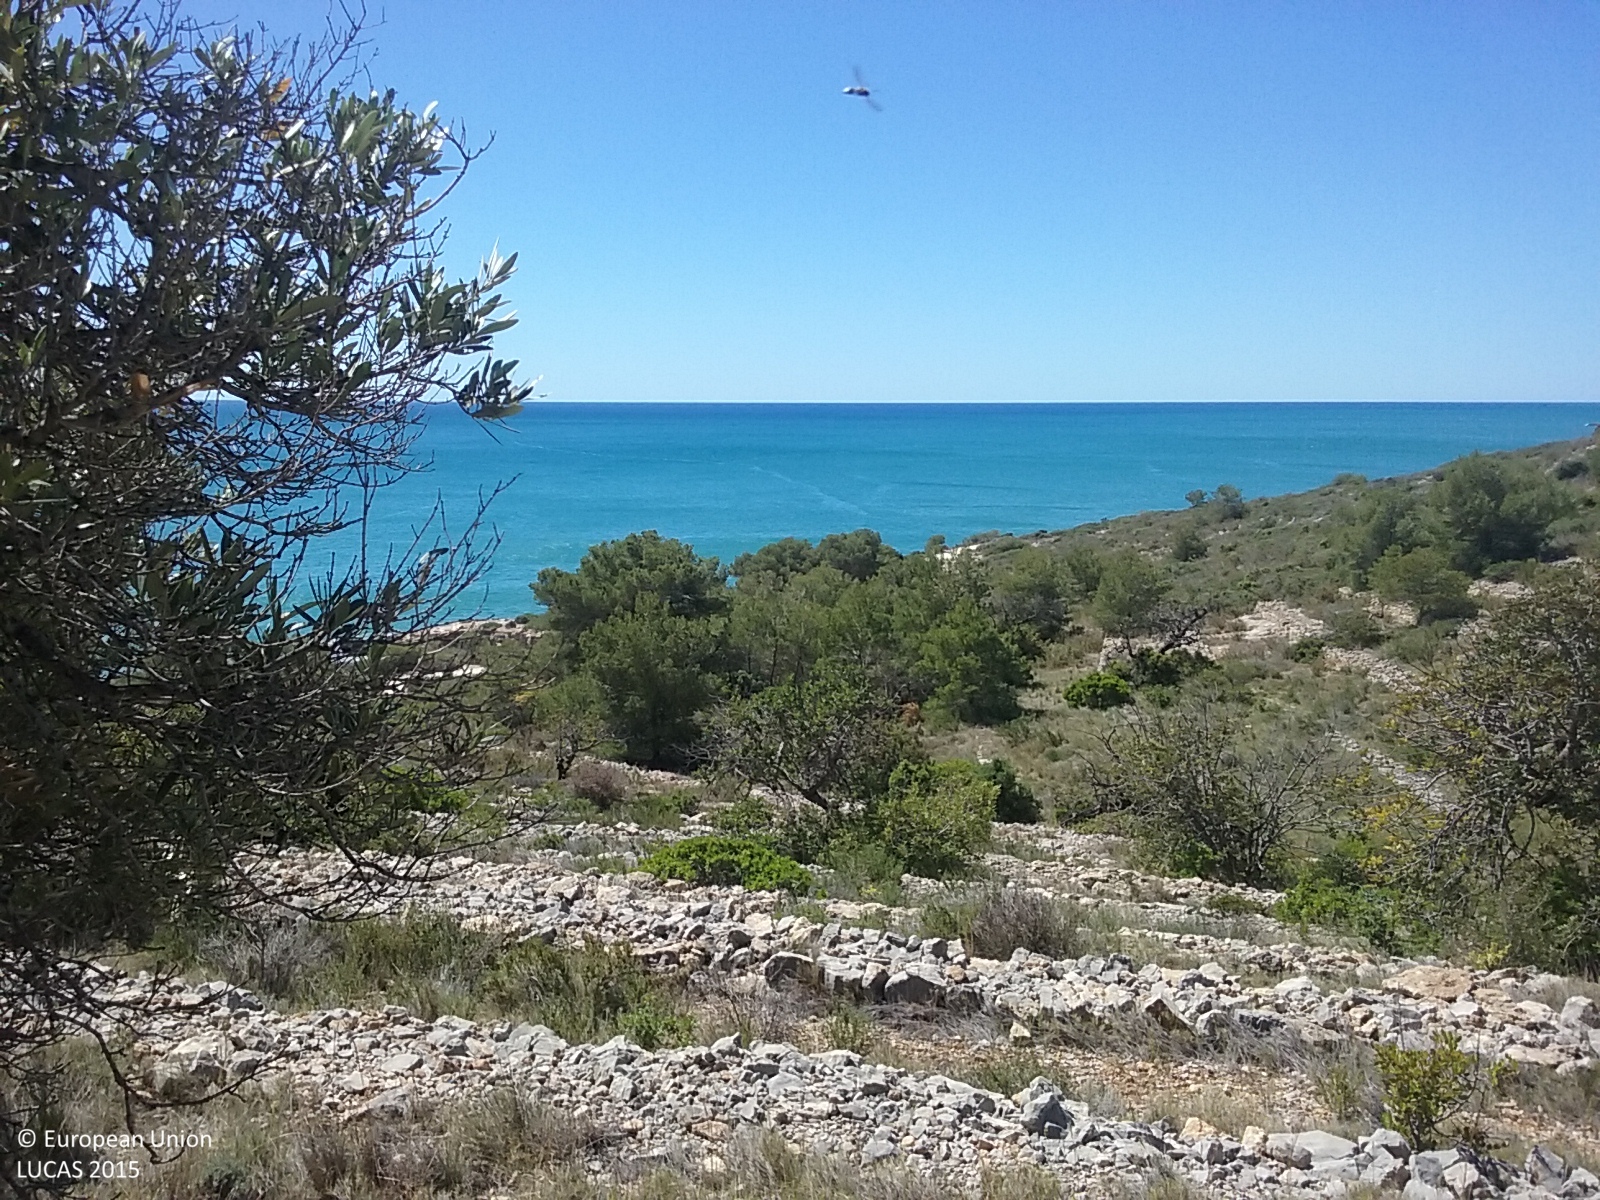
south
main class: Shrubland
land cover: Shrubland with sparse tree cover
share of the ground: 25 - 50 %
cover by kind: herbaceous plants 40 %, shrubs 20 %, coniferous forest trees 5 %
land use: Semi-natural and natural areas not in use
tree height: > 5 m
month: May
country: ES
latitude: 40.3195
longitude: 0.3593
